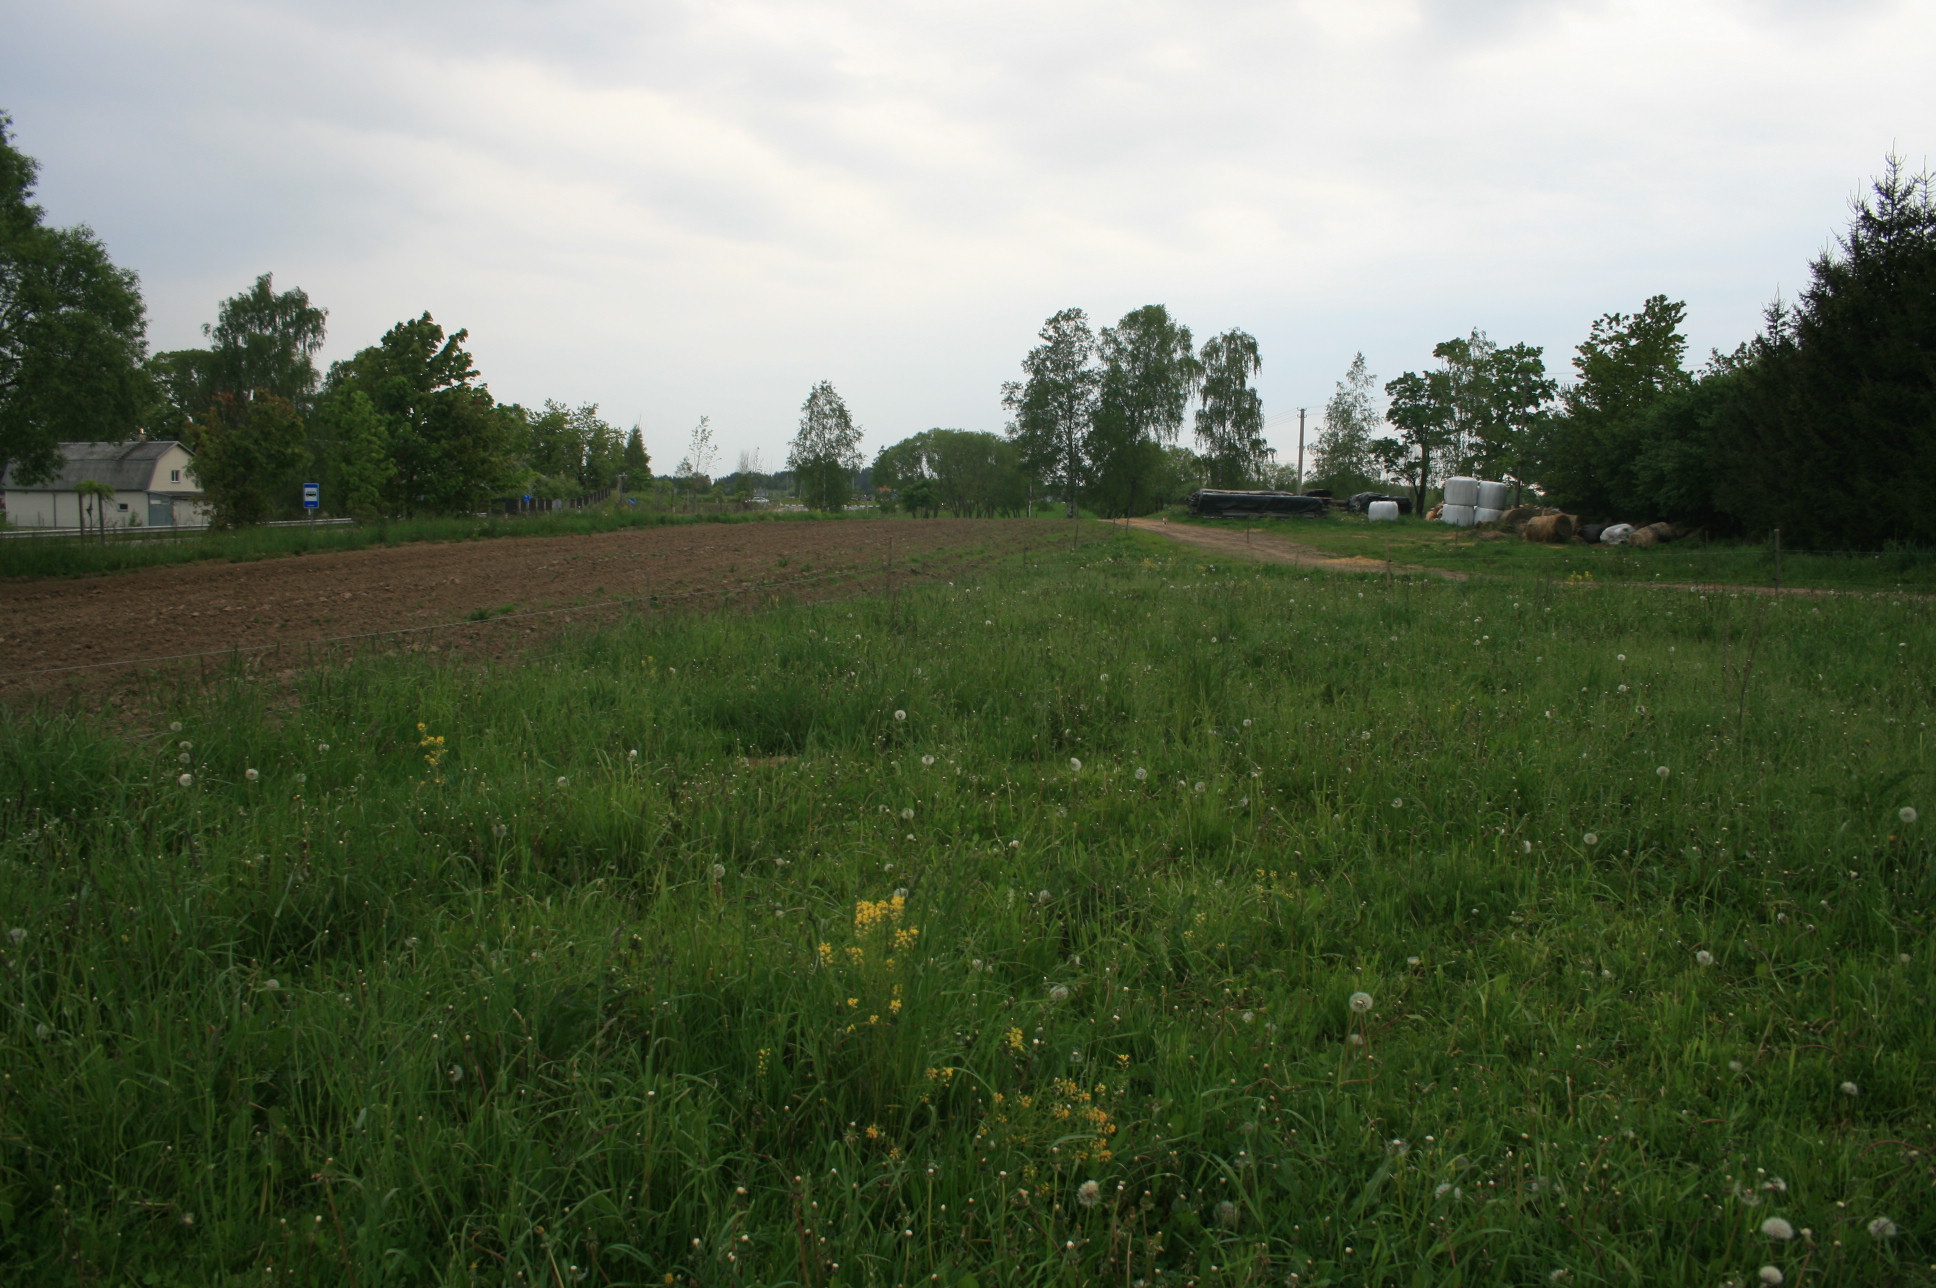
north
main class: Grassland
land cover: Grassland without tree/shrub cover
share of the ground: > 75 %
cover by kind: herbaceous plants 100 %
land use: Agriculture (excluding fallow land and kitchen gardens)
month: May
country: LT
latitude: 55.8896
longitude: 21.8657
